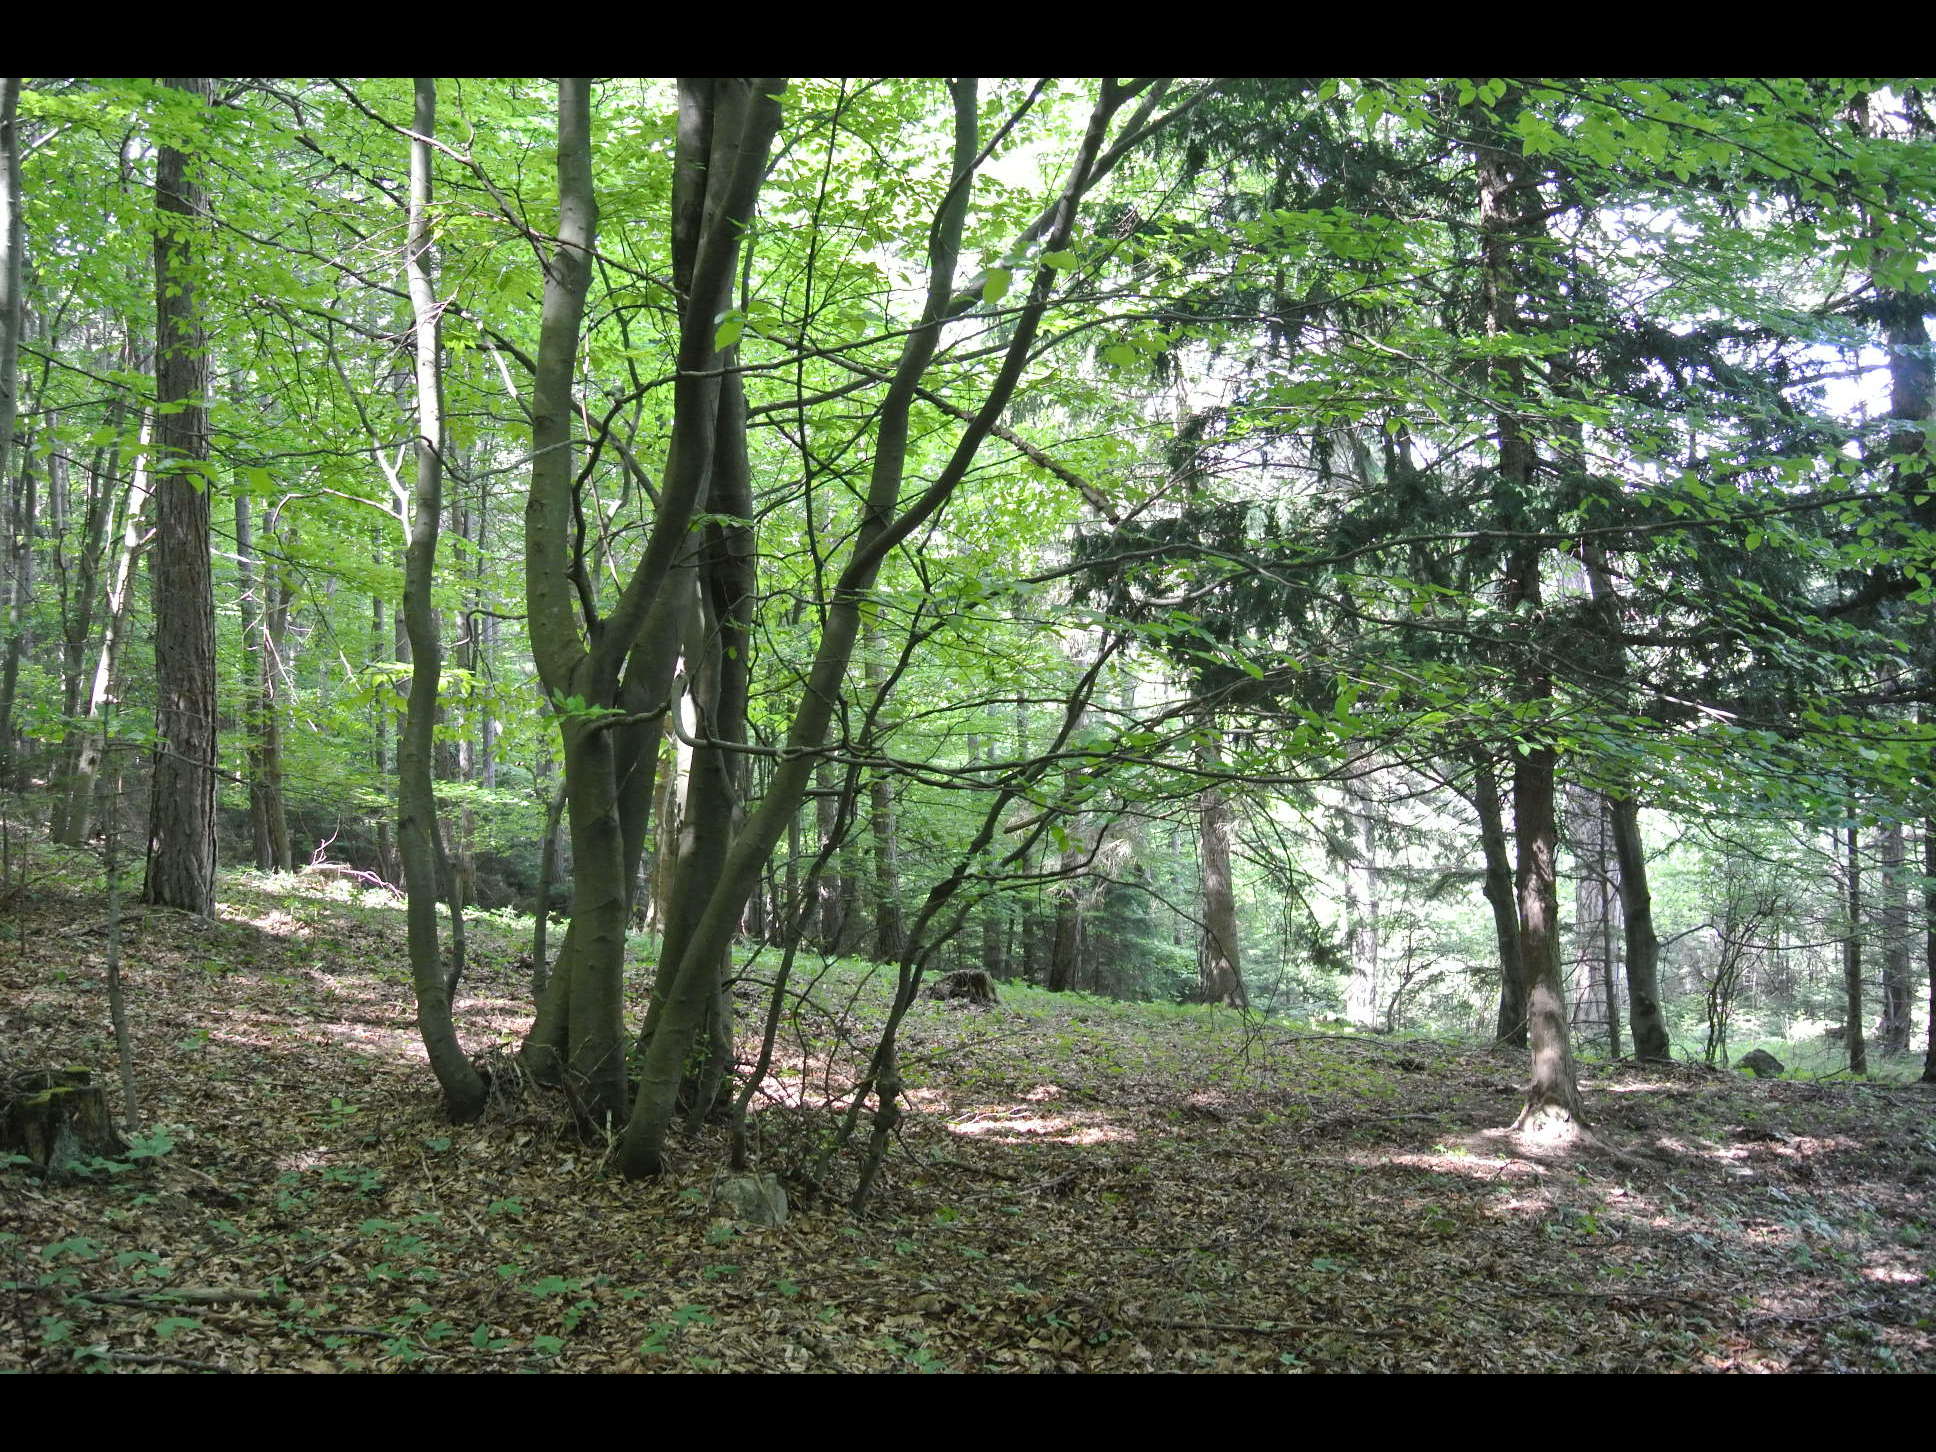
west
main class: Woodland
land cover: Other mixed woodland
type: mountainous beech forest
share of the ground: > 75 %
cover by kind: broadleaved forest trees 65 %, coniferous forest trees 35 %
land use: Forestry
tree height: > 5 m
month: May
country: AT
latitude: 47.8584
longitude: 16.0581
